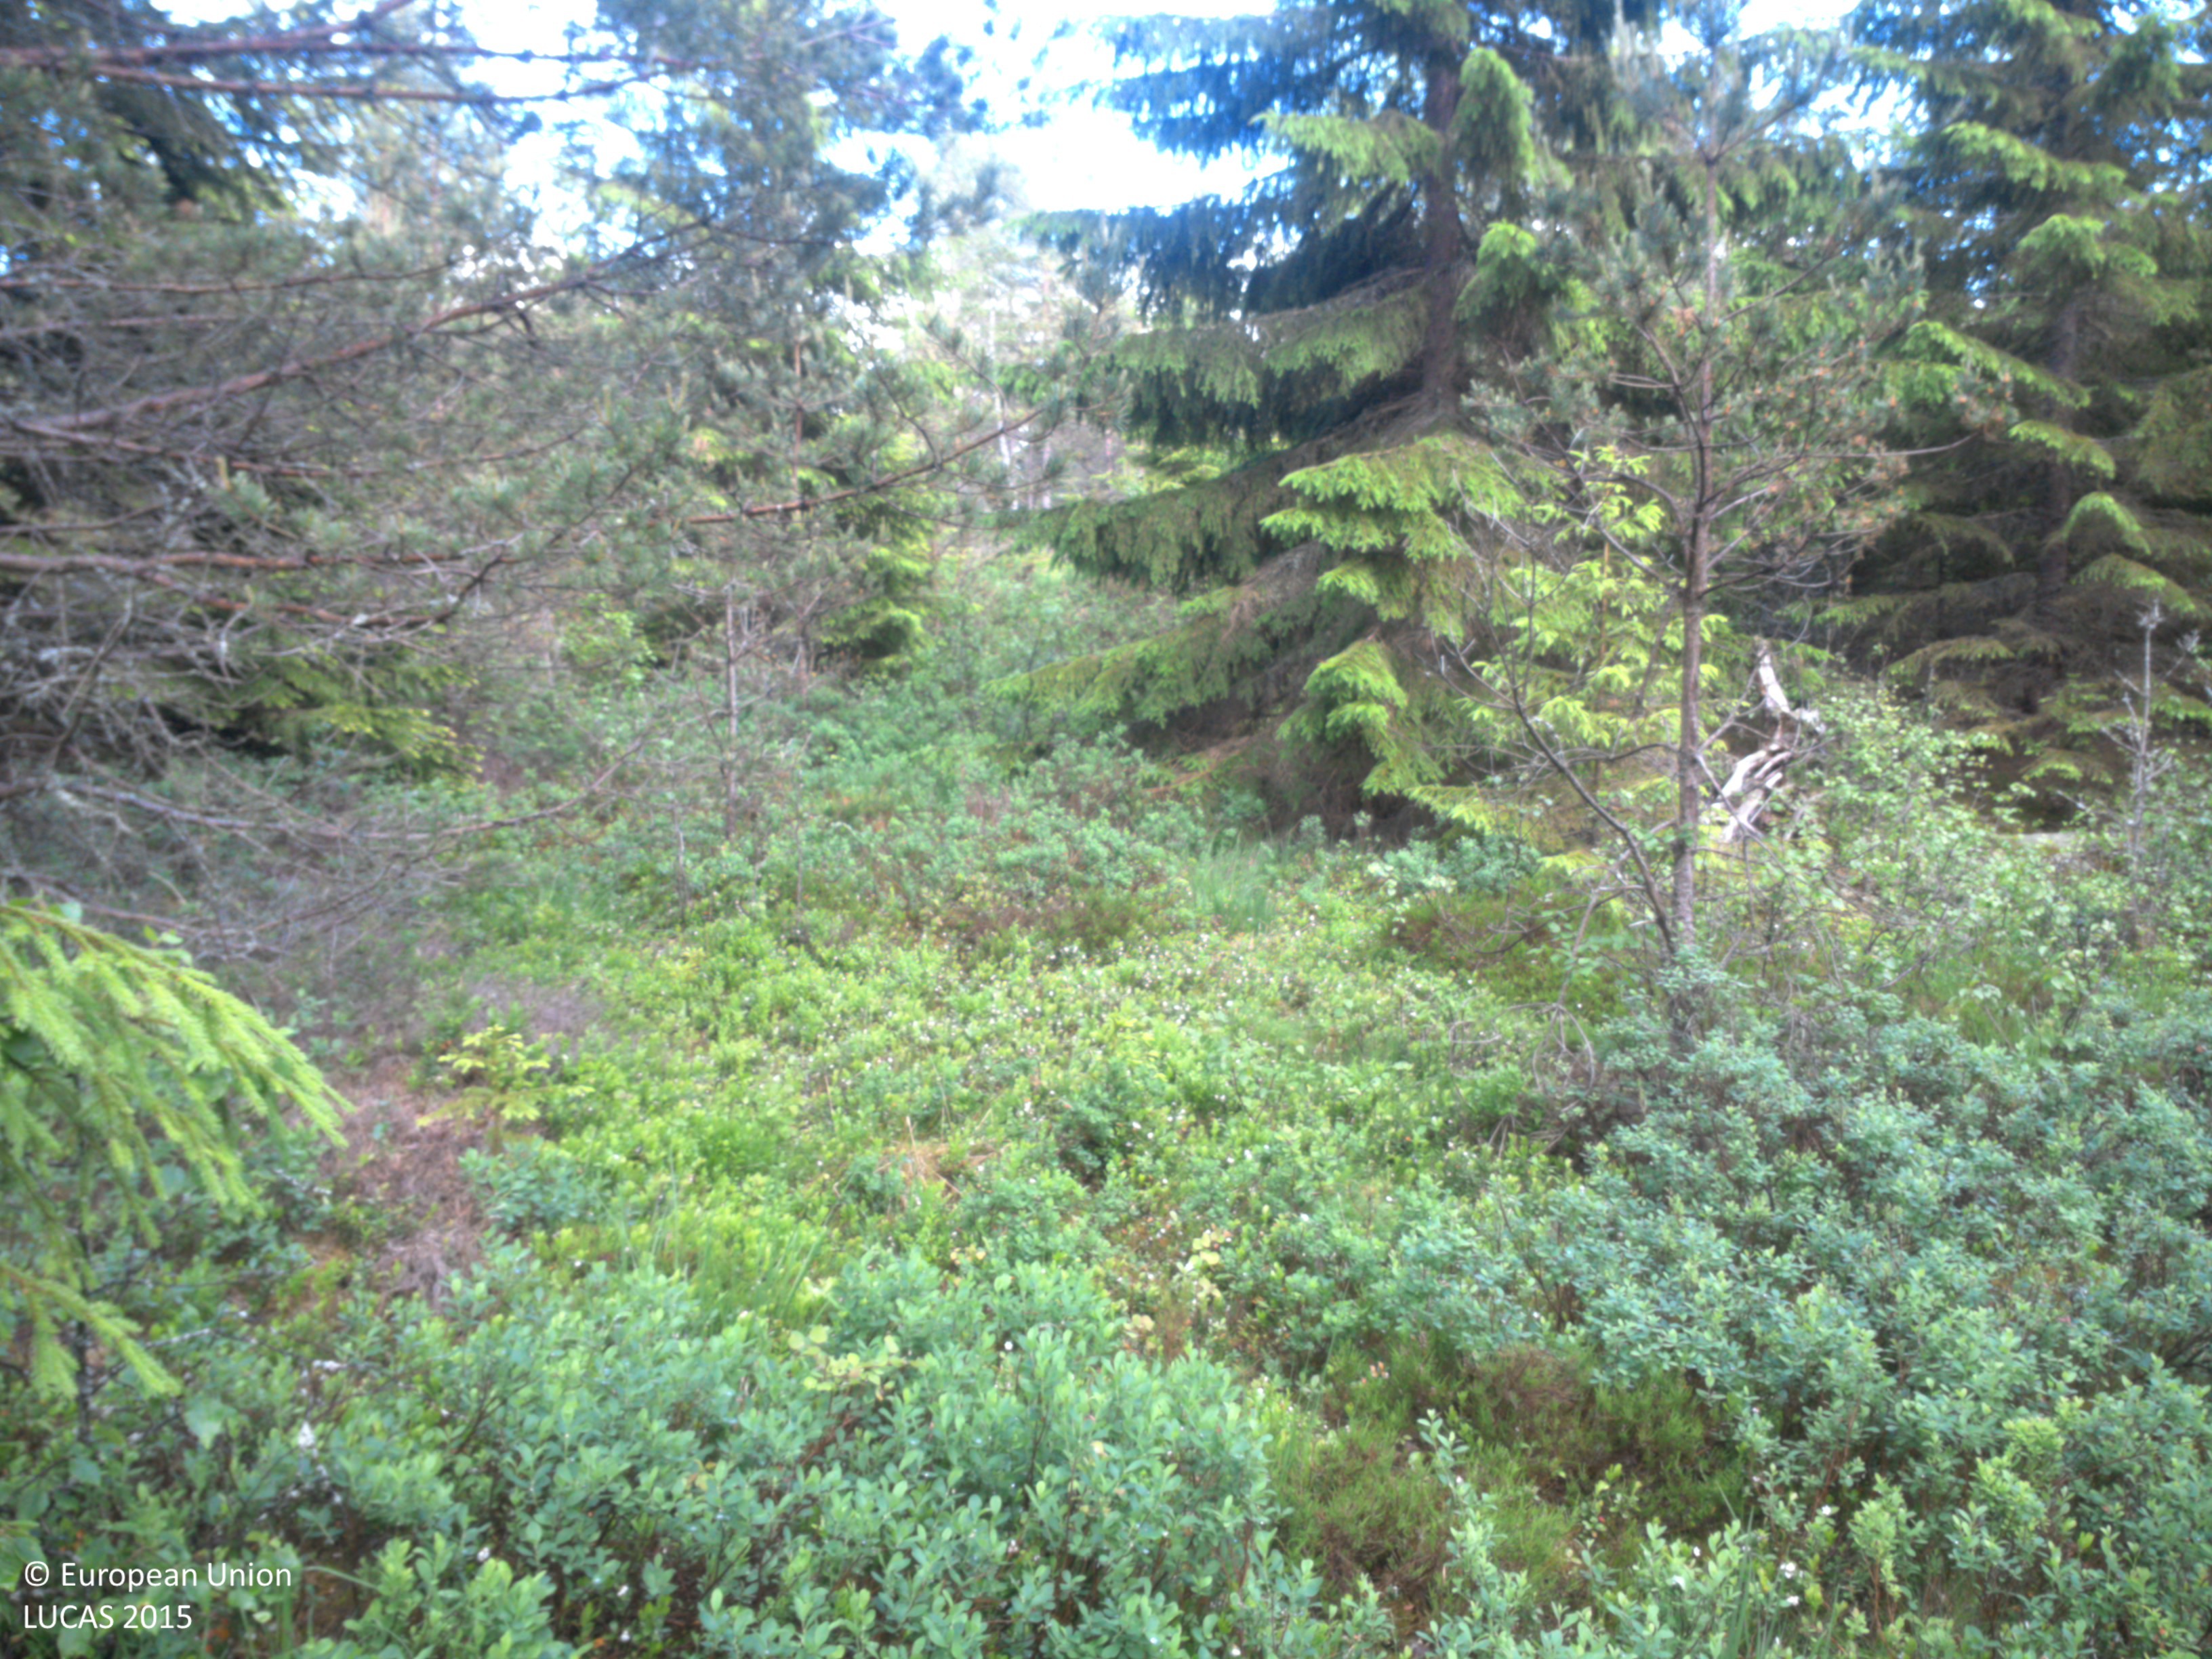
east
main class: Woodland
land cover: Other mixed woodland
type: boreal forest
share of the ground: 50 - 75 %
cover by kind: coniferous forest trees 50 %, herbaceous plants 30 %, broadleaved forest trees 20 %
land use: Forestry
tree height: > 5 m
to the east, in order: Other mixed woodland; Pine dominated coniferous woodland; Pine dominated mixed woodland; Rock outcrops; Pine dominated mixed woodland; Pine dominated coniferous woodland; Rock outcrops; Pine dominated coniferous woodland
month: June
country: SE
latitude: 58.8575
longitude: 11.6085
